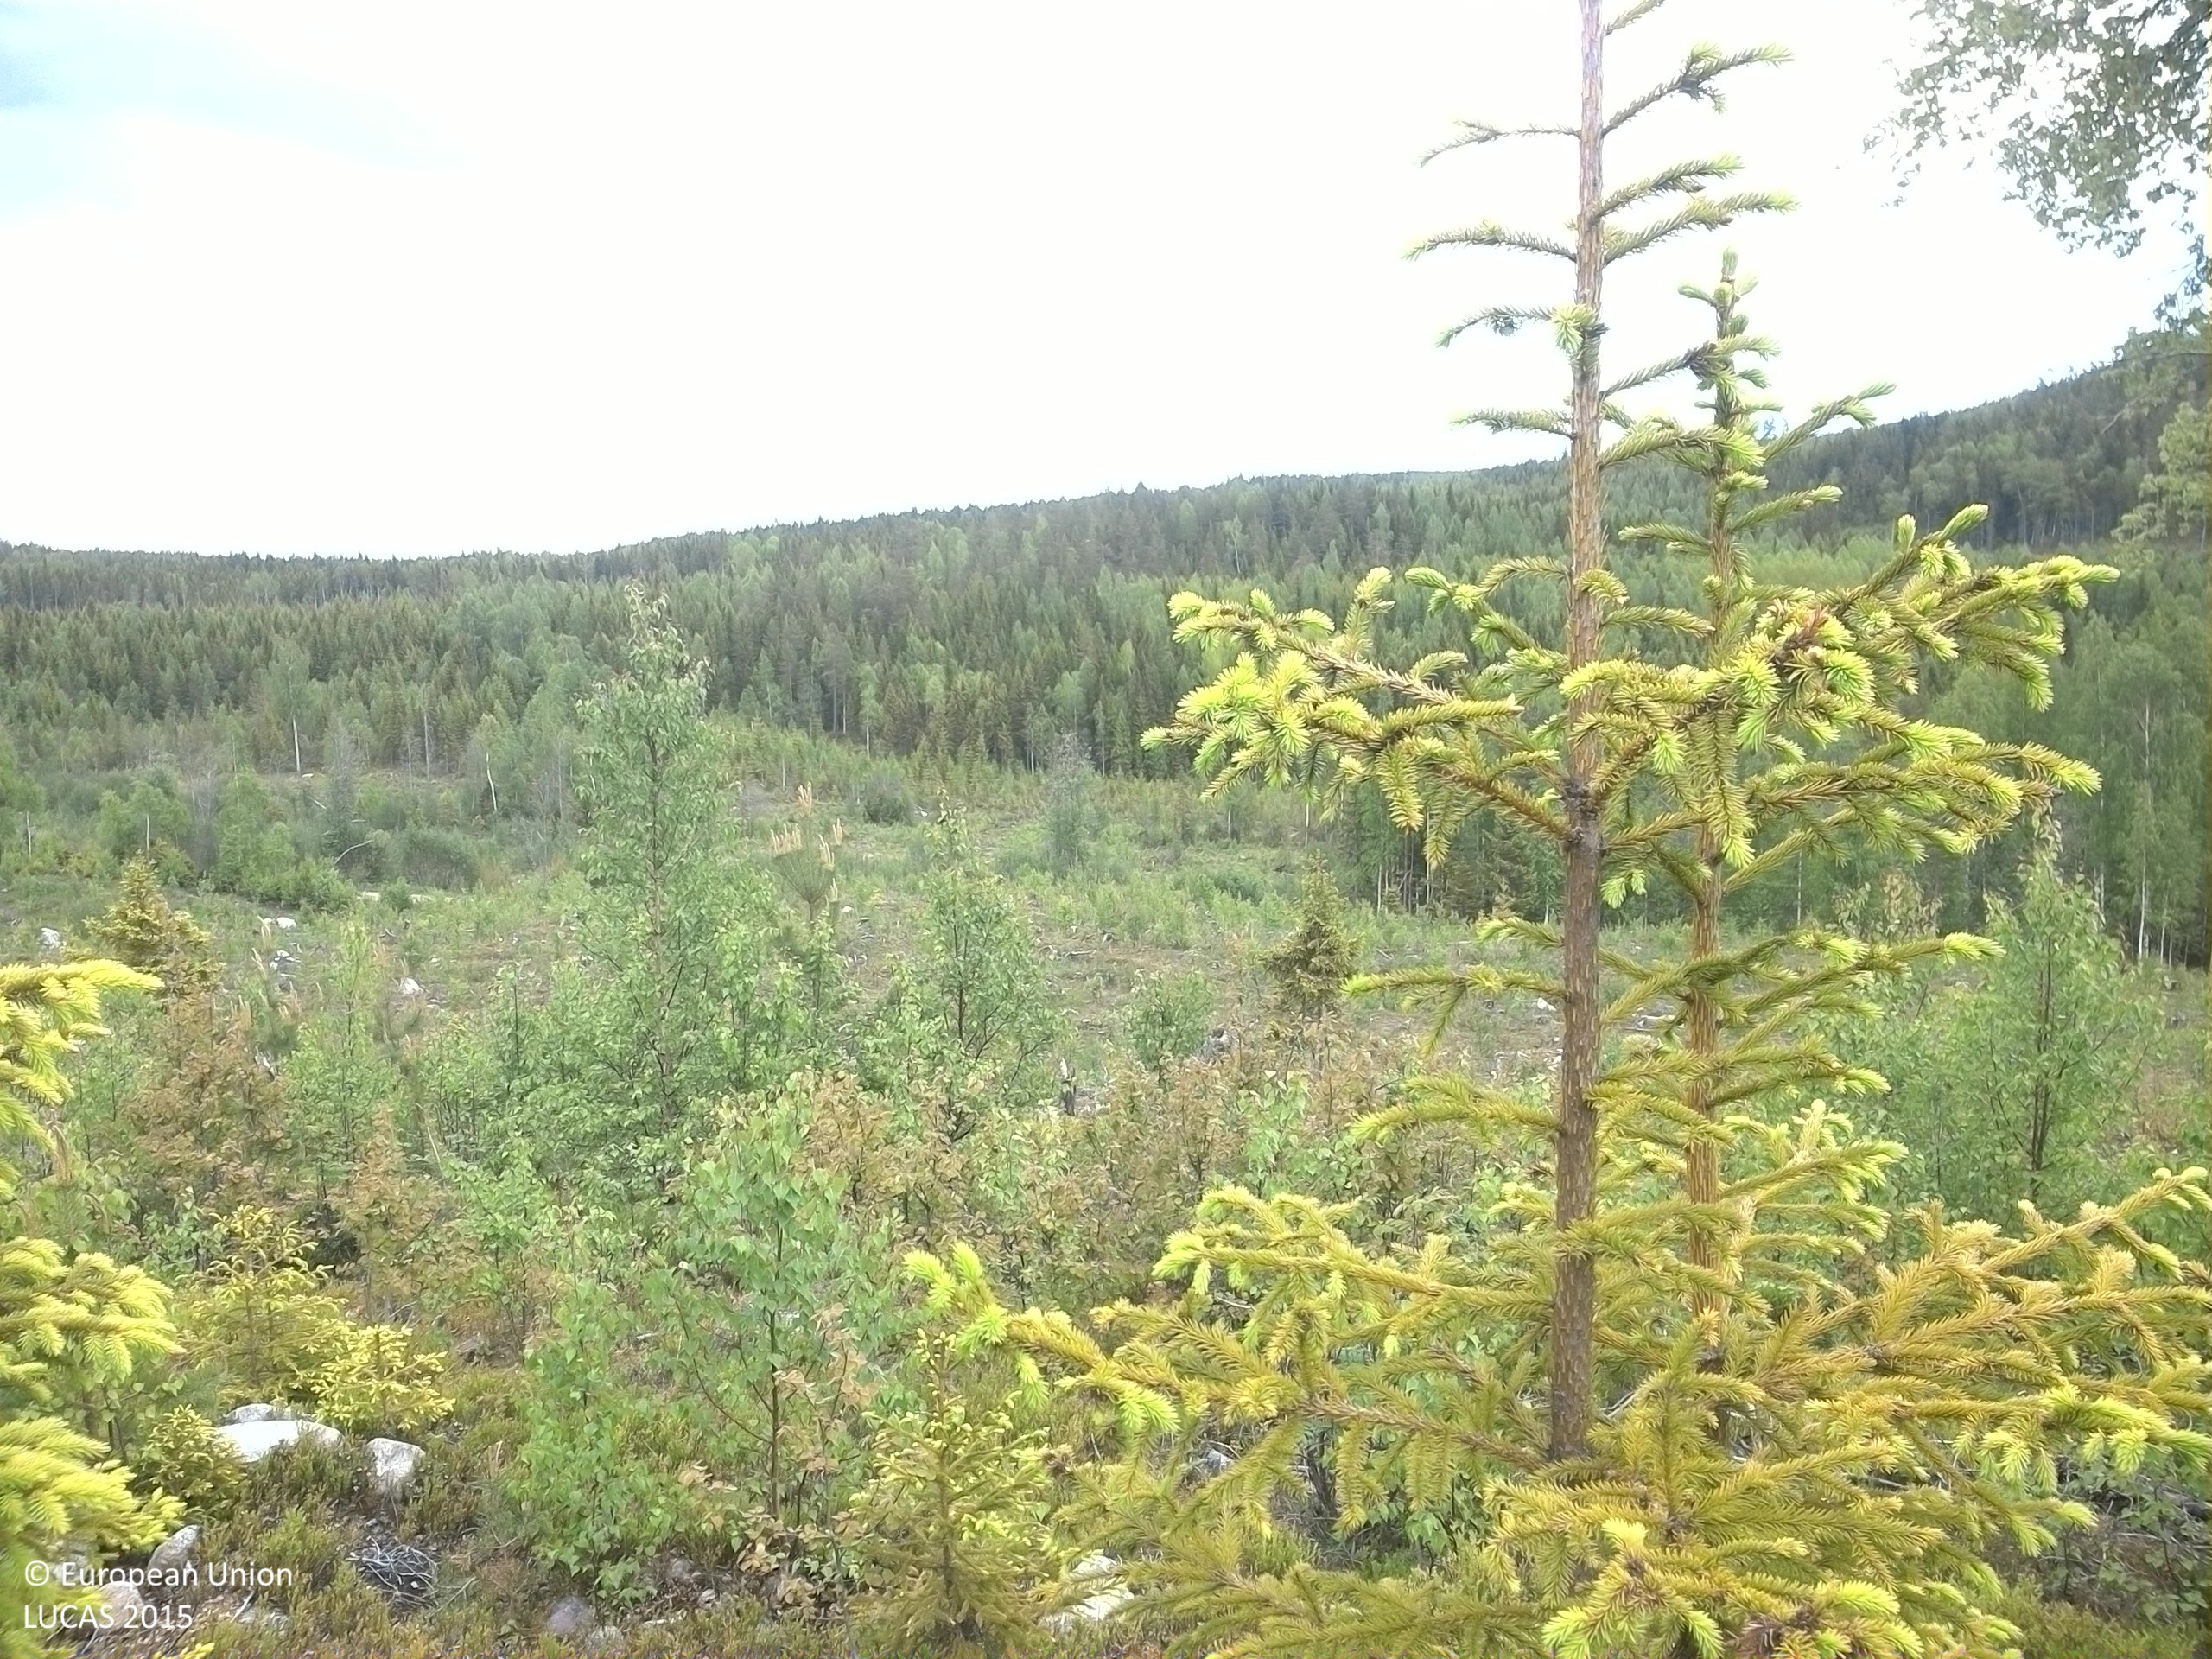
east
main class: Woodland
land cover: Pine dominated mixed woodland
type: exotic forest
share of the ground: 50 - 75 %
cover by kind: shrubs 45 %, coniferous forest trees 35 %, broadleaved forest trees 20 %
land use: Forestry
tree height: < 5 m
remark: Clear cut
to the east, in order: Pine dominated mixed woodland; Broadleaved woodland; Spruce dominated mixed woodland; Ditches and canals; Paved roads, cycling and walking lanes; Grass margins; Broadleaved woodland; Spruce dominated mixed woodland
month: June
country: SE
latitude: 63.4805
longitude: 18.1454
